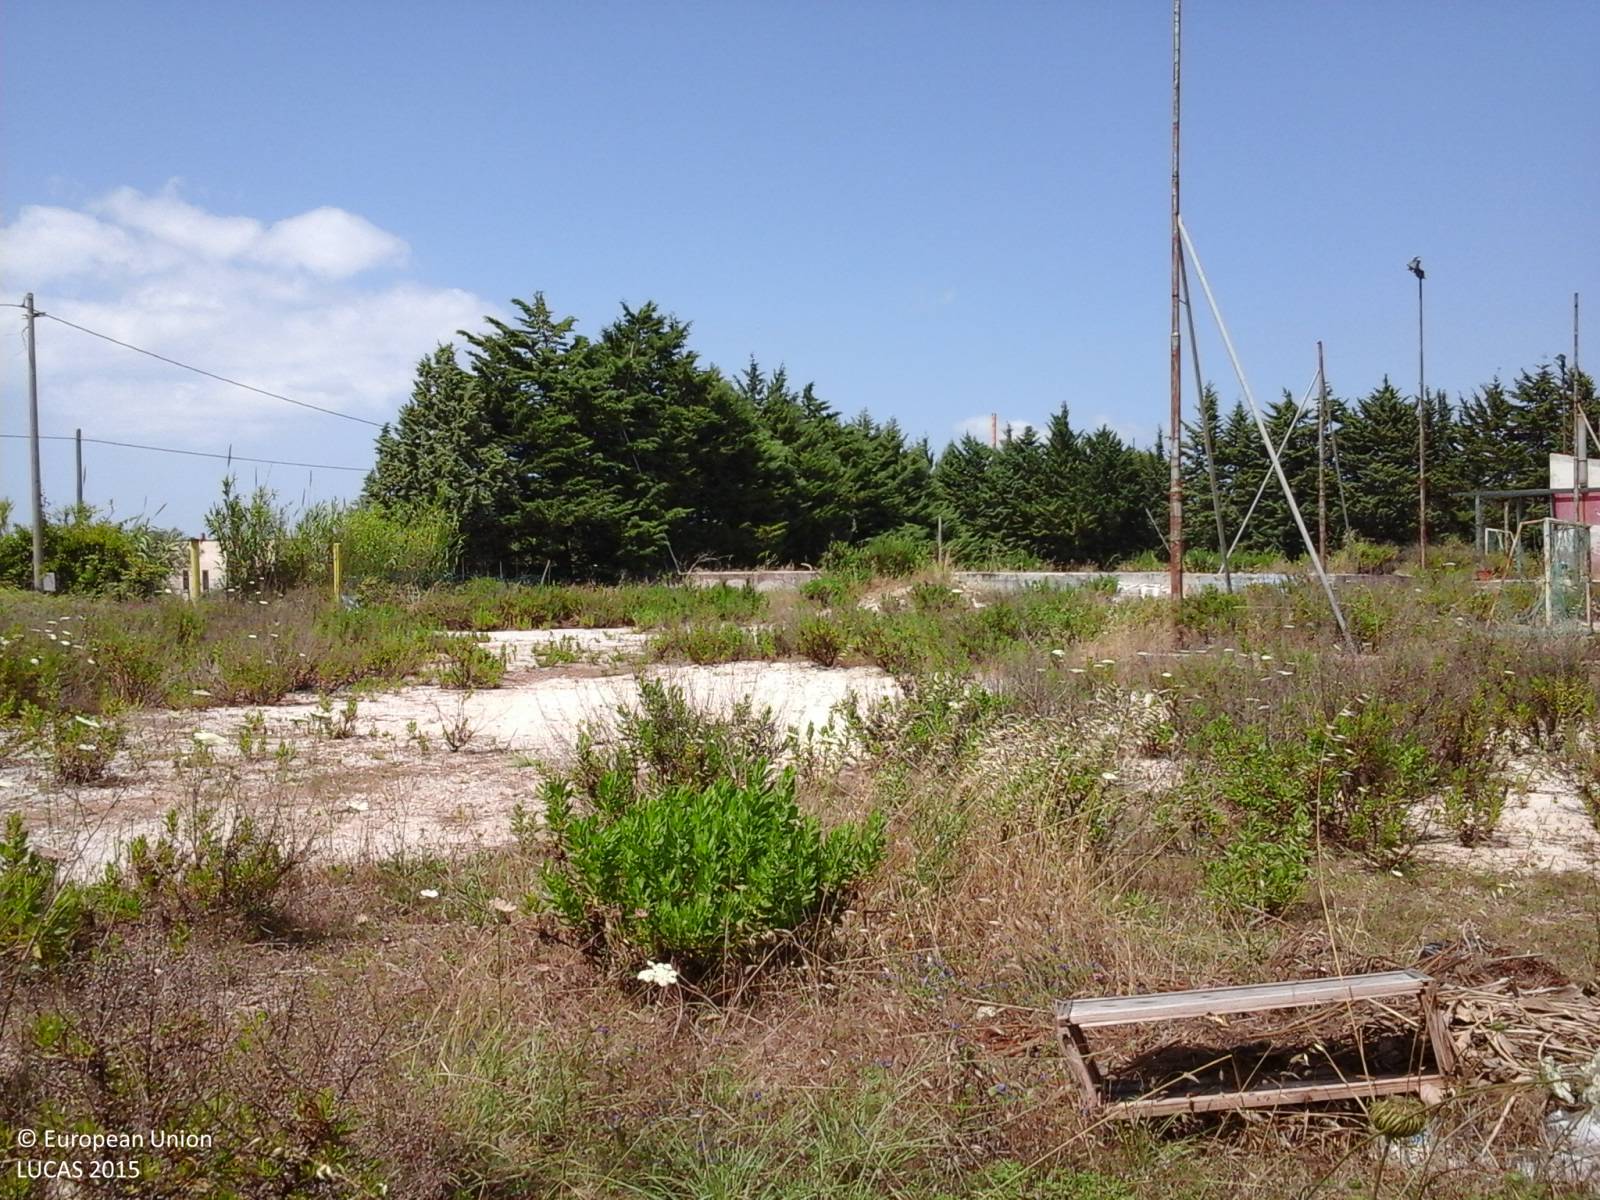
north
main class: Grassland
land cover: Grassland without tree/shrub cover
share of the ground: > 75 %
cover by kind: herbaceous plants 100 %
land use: Abandoned areas
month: June
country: IT
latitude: 38.0243
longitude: 13.0879
